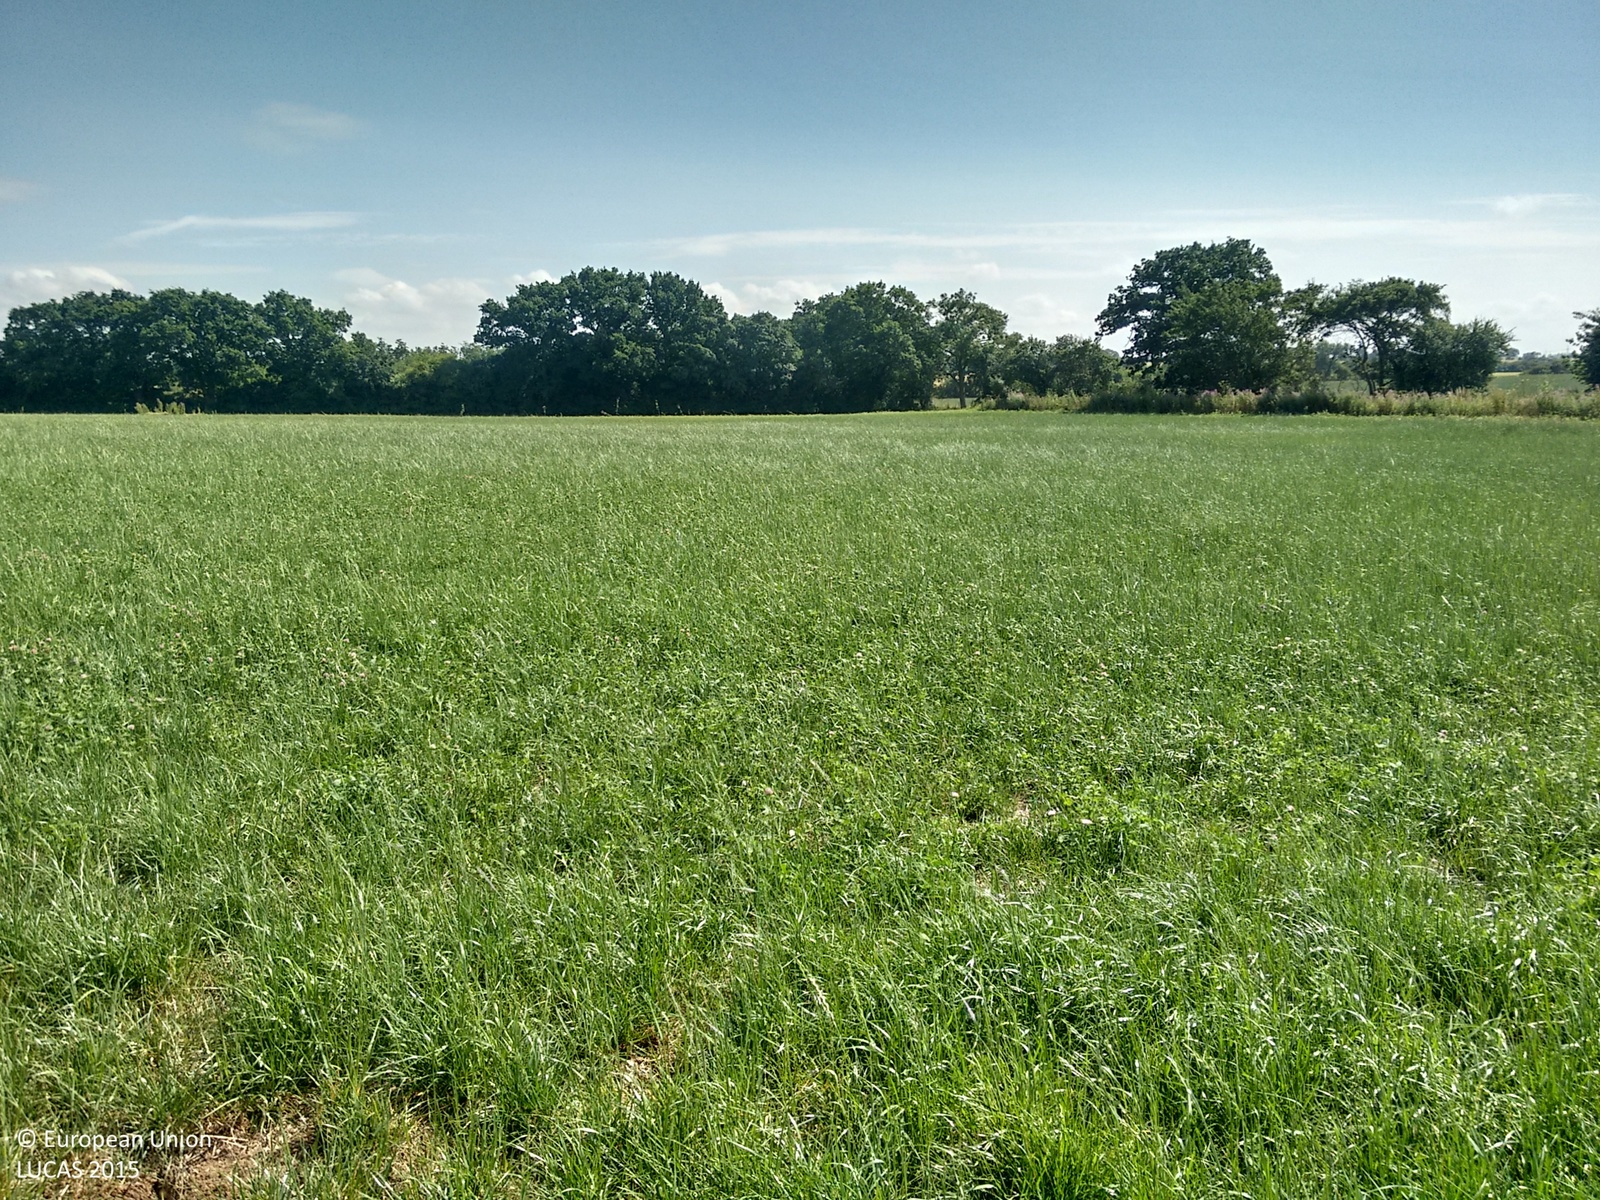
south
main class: Cropland
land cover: Temporary grasslands
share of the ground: > 75 %
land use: Agriculture (excluding fallow land and kitchen gardens)
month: July
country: GB
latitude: 51.6746
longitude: 0.5586
